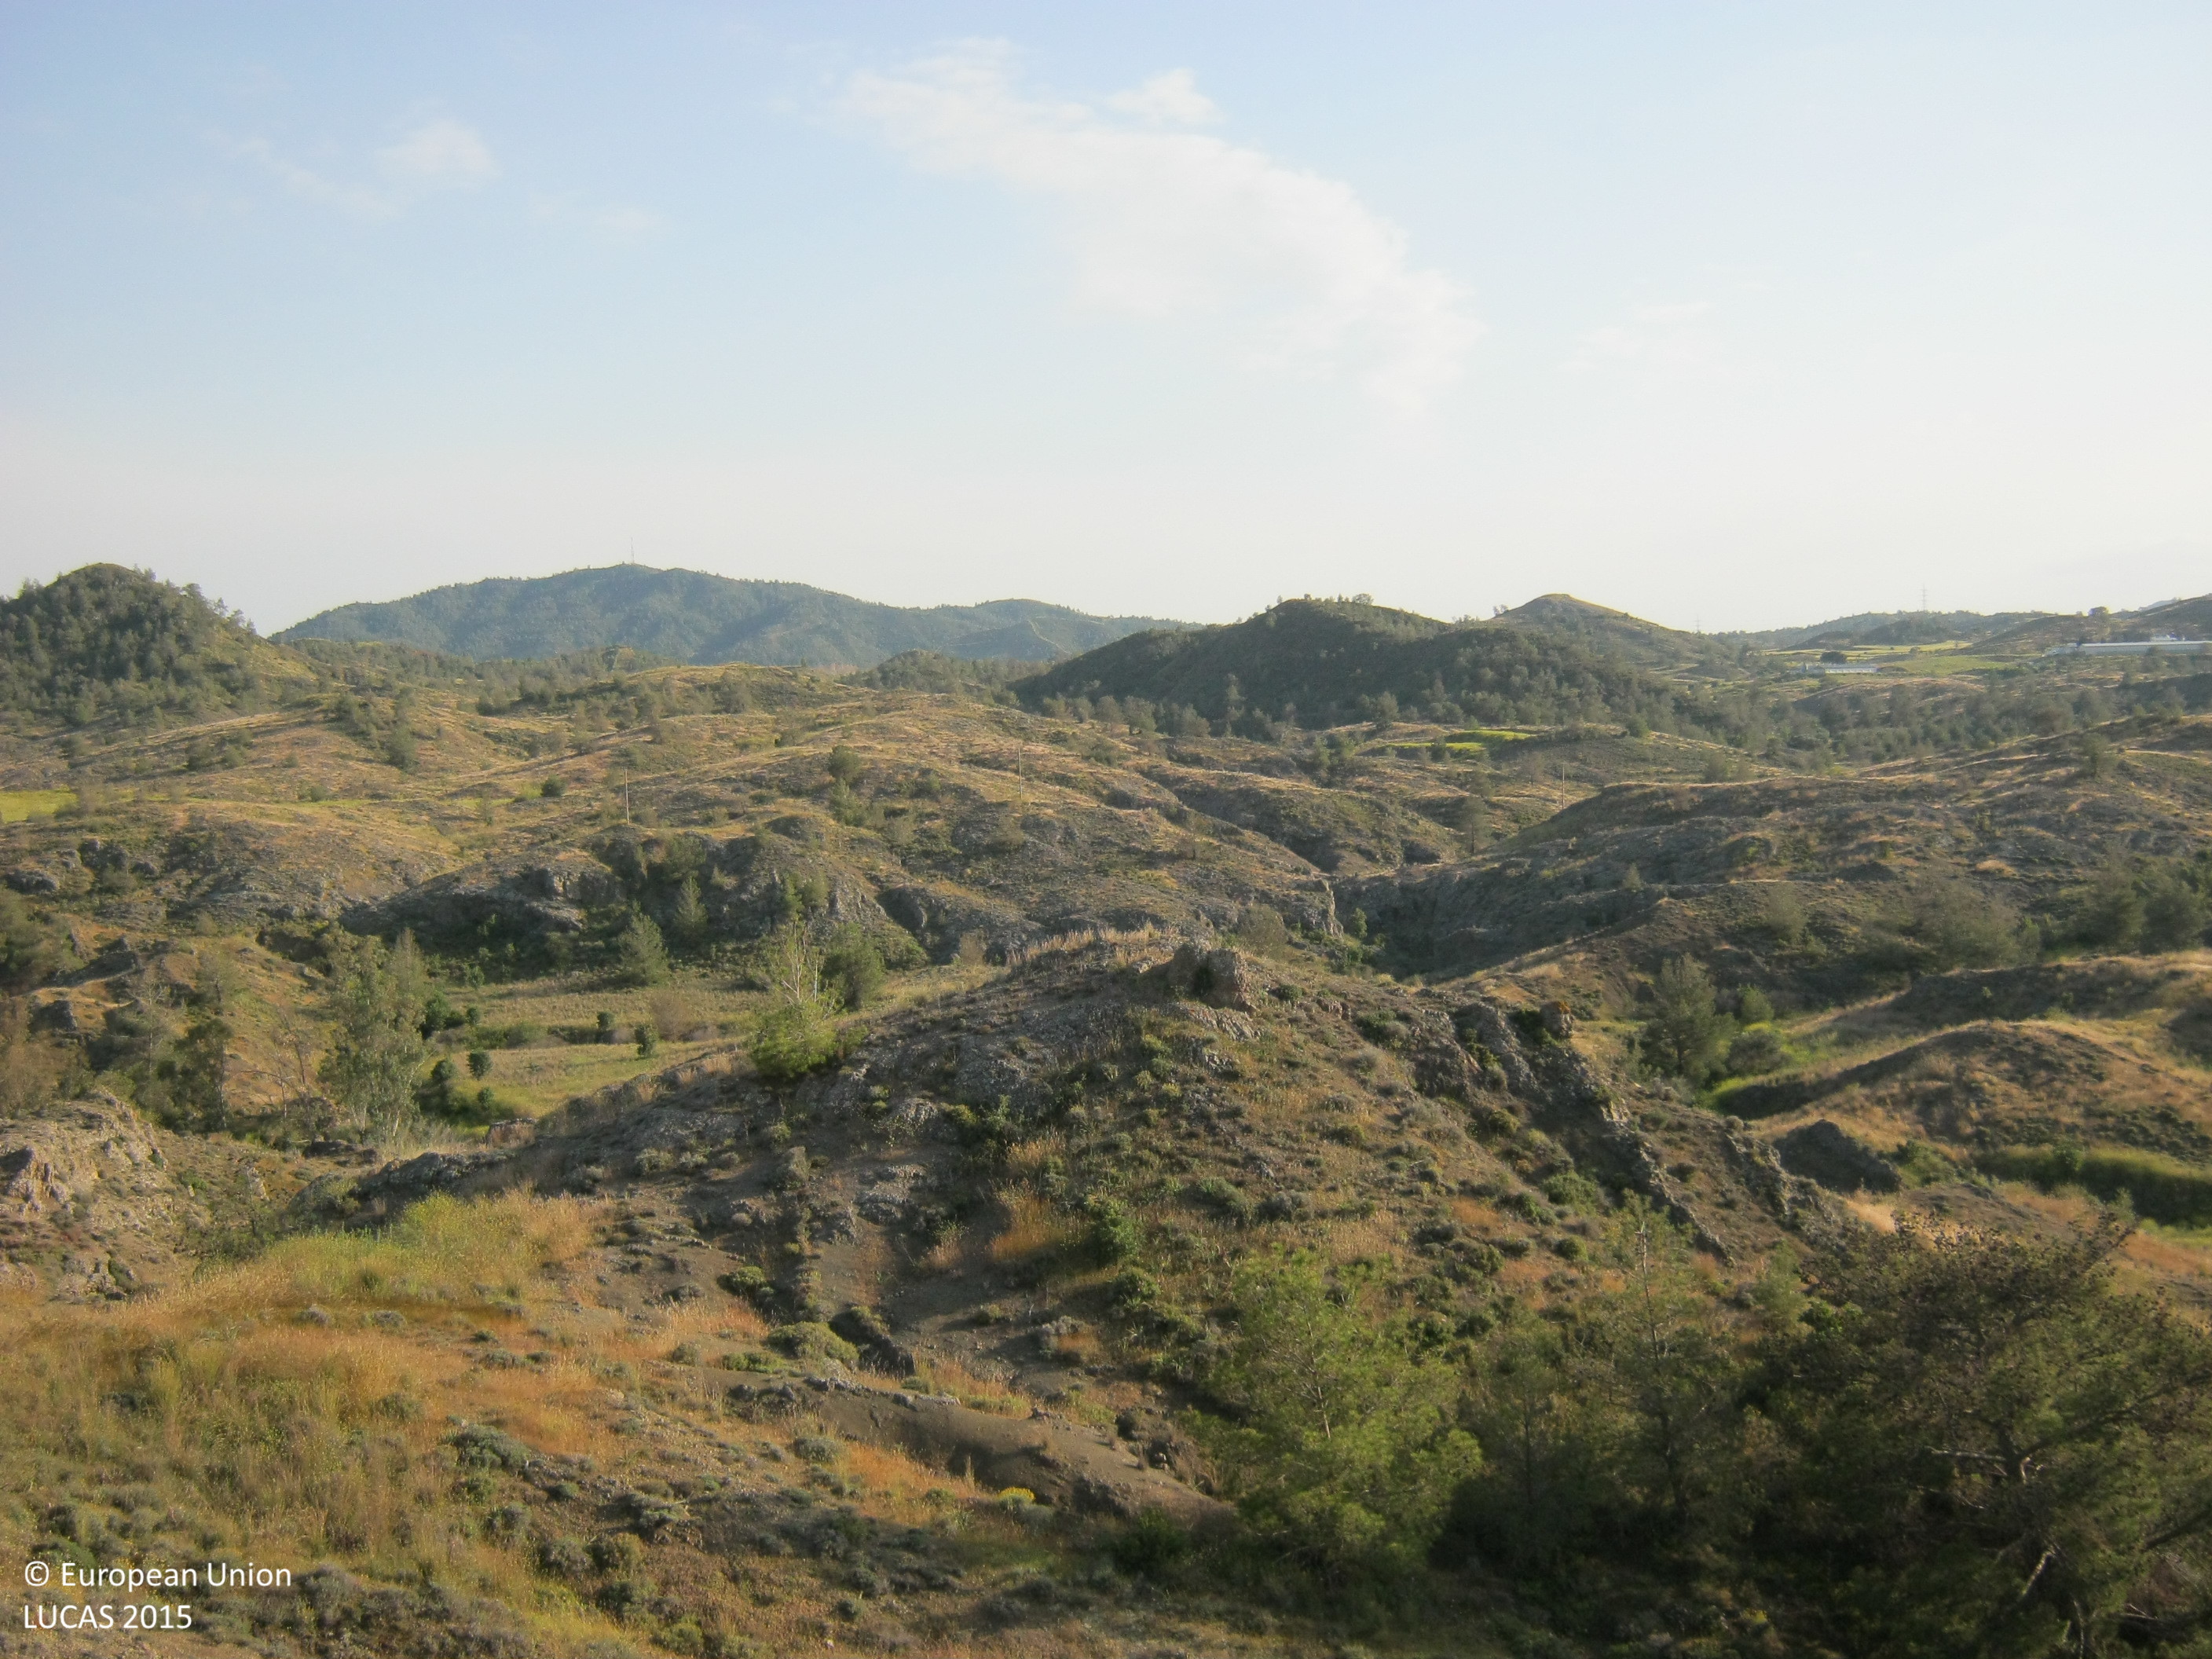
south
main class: Shrubland
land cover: Shrubland without tree cover
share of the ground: 25 - 50 %
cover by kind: unconsolidated bare surface 30 %, shrubs 25 %, herbaceous plants 25 %, consolidated bare surface 20 %
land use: Semi-natural and natural areas not in use
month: April
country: CY
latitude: 34.9781
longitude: 33.3775
